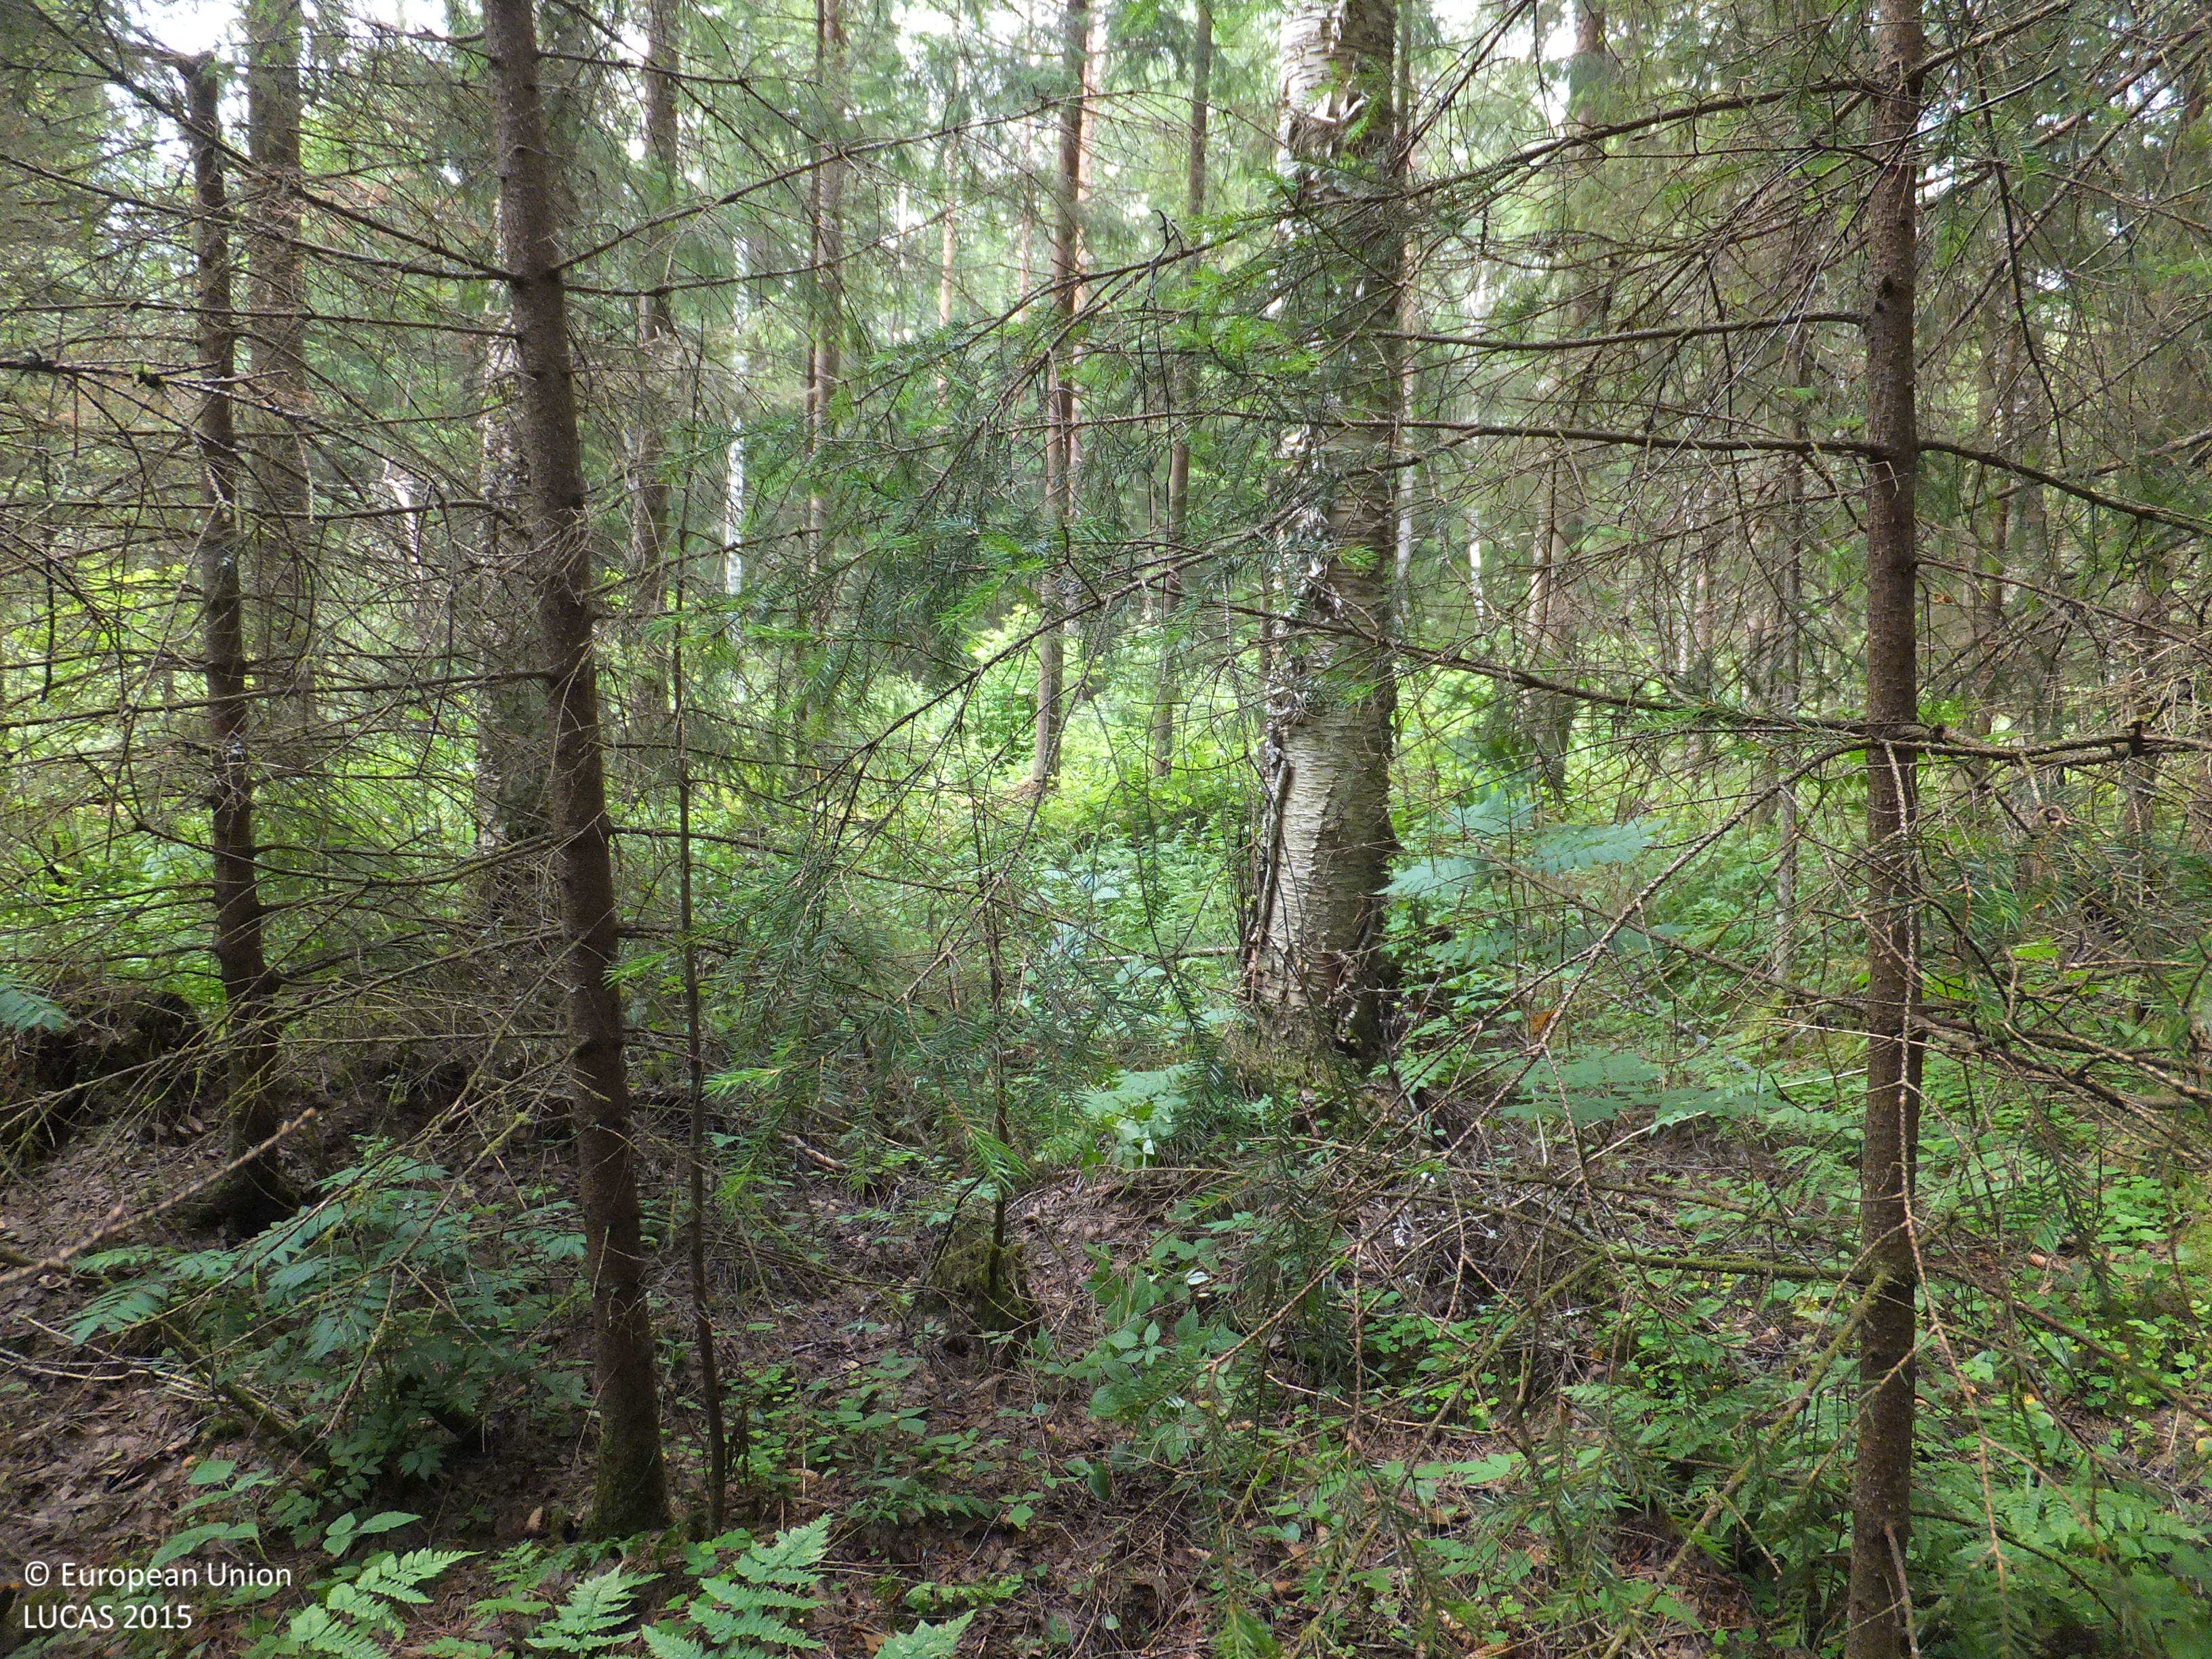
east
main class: Woodland
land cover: Other mixed woodland
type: boreal forest
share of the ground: > 75 %
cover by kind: coniferous forest trees 60 %, broadleaved forest trees 30 %, herbaceous plants 5 %, lichens and mosses 5 %
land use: Forestry
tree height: > 5 m
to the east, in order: Other mixed woodland; Ditches and canals; Grassland without tree/shrub cover; Other mixed woodland; Spontaneously vegetated surfaces; Spruce dominated mixed woodland; Other mixed woodland; Pine dominated mixed woodland; Pine dominated coniferous woodland
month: July
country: FI
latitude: 63.6530
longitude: 23.2853
